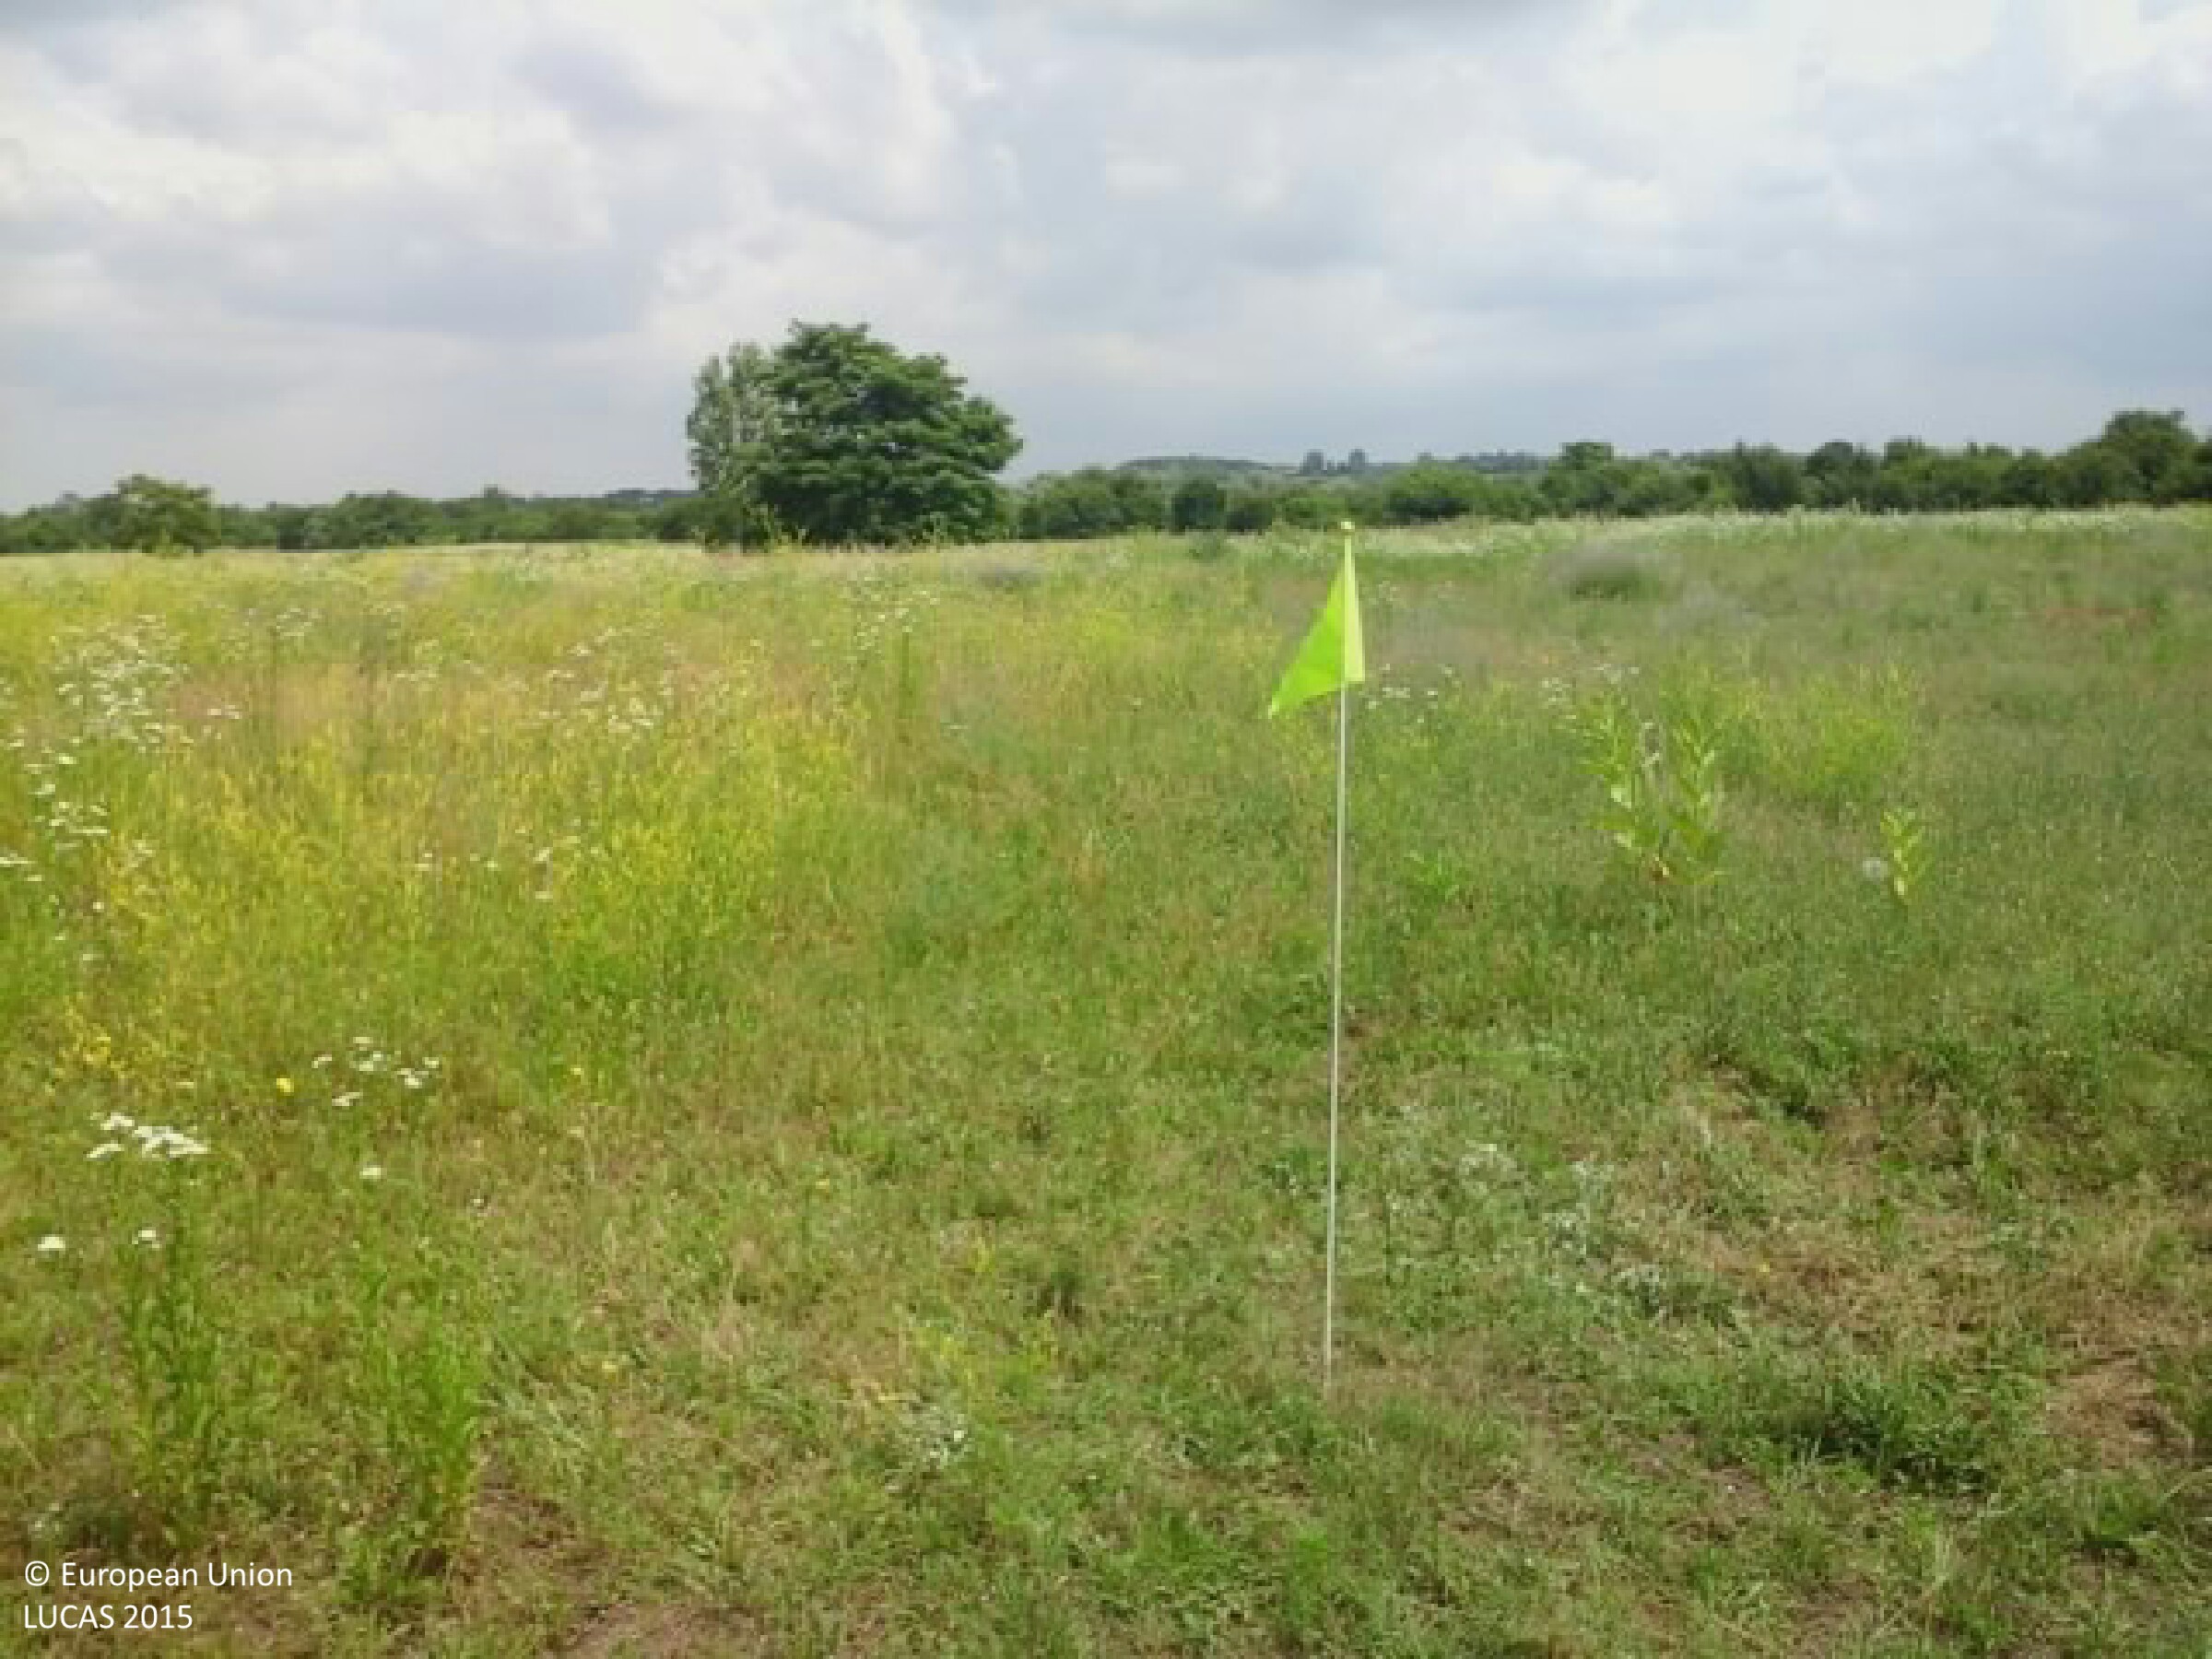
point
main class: Grassland
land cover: Grassland with sparse tree/shrub cover
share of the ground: > 75 %
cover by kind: herbaceous plants 95 %, broadleaved forest trees 5 %
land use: Agriculture (excluding fallow land and kitchen gardens)
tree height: < 5 m
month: June
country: HU
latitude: 47.5862
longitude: 19.1807
